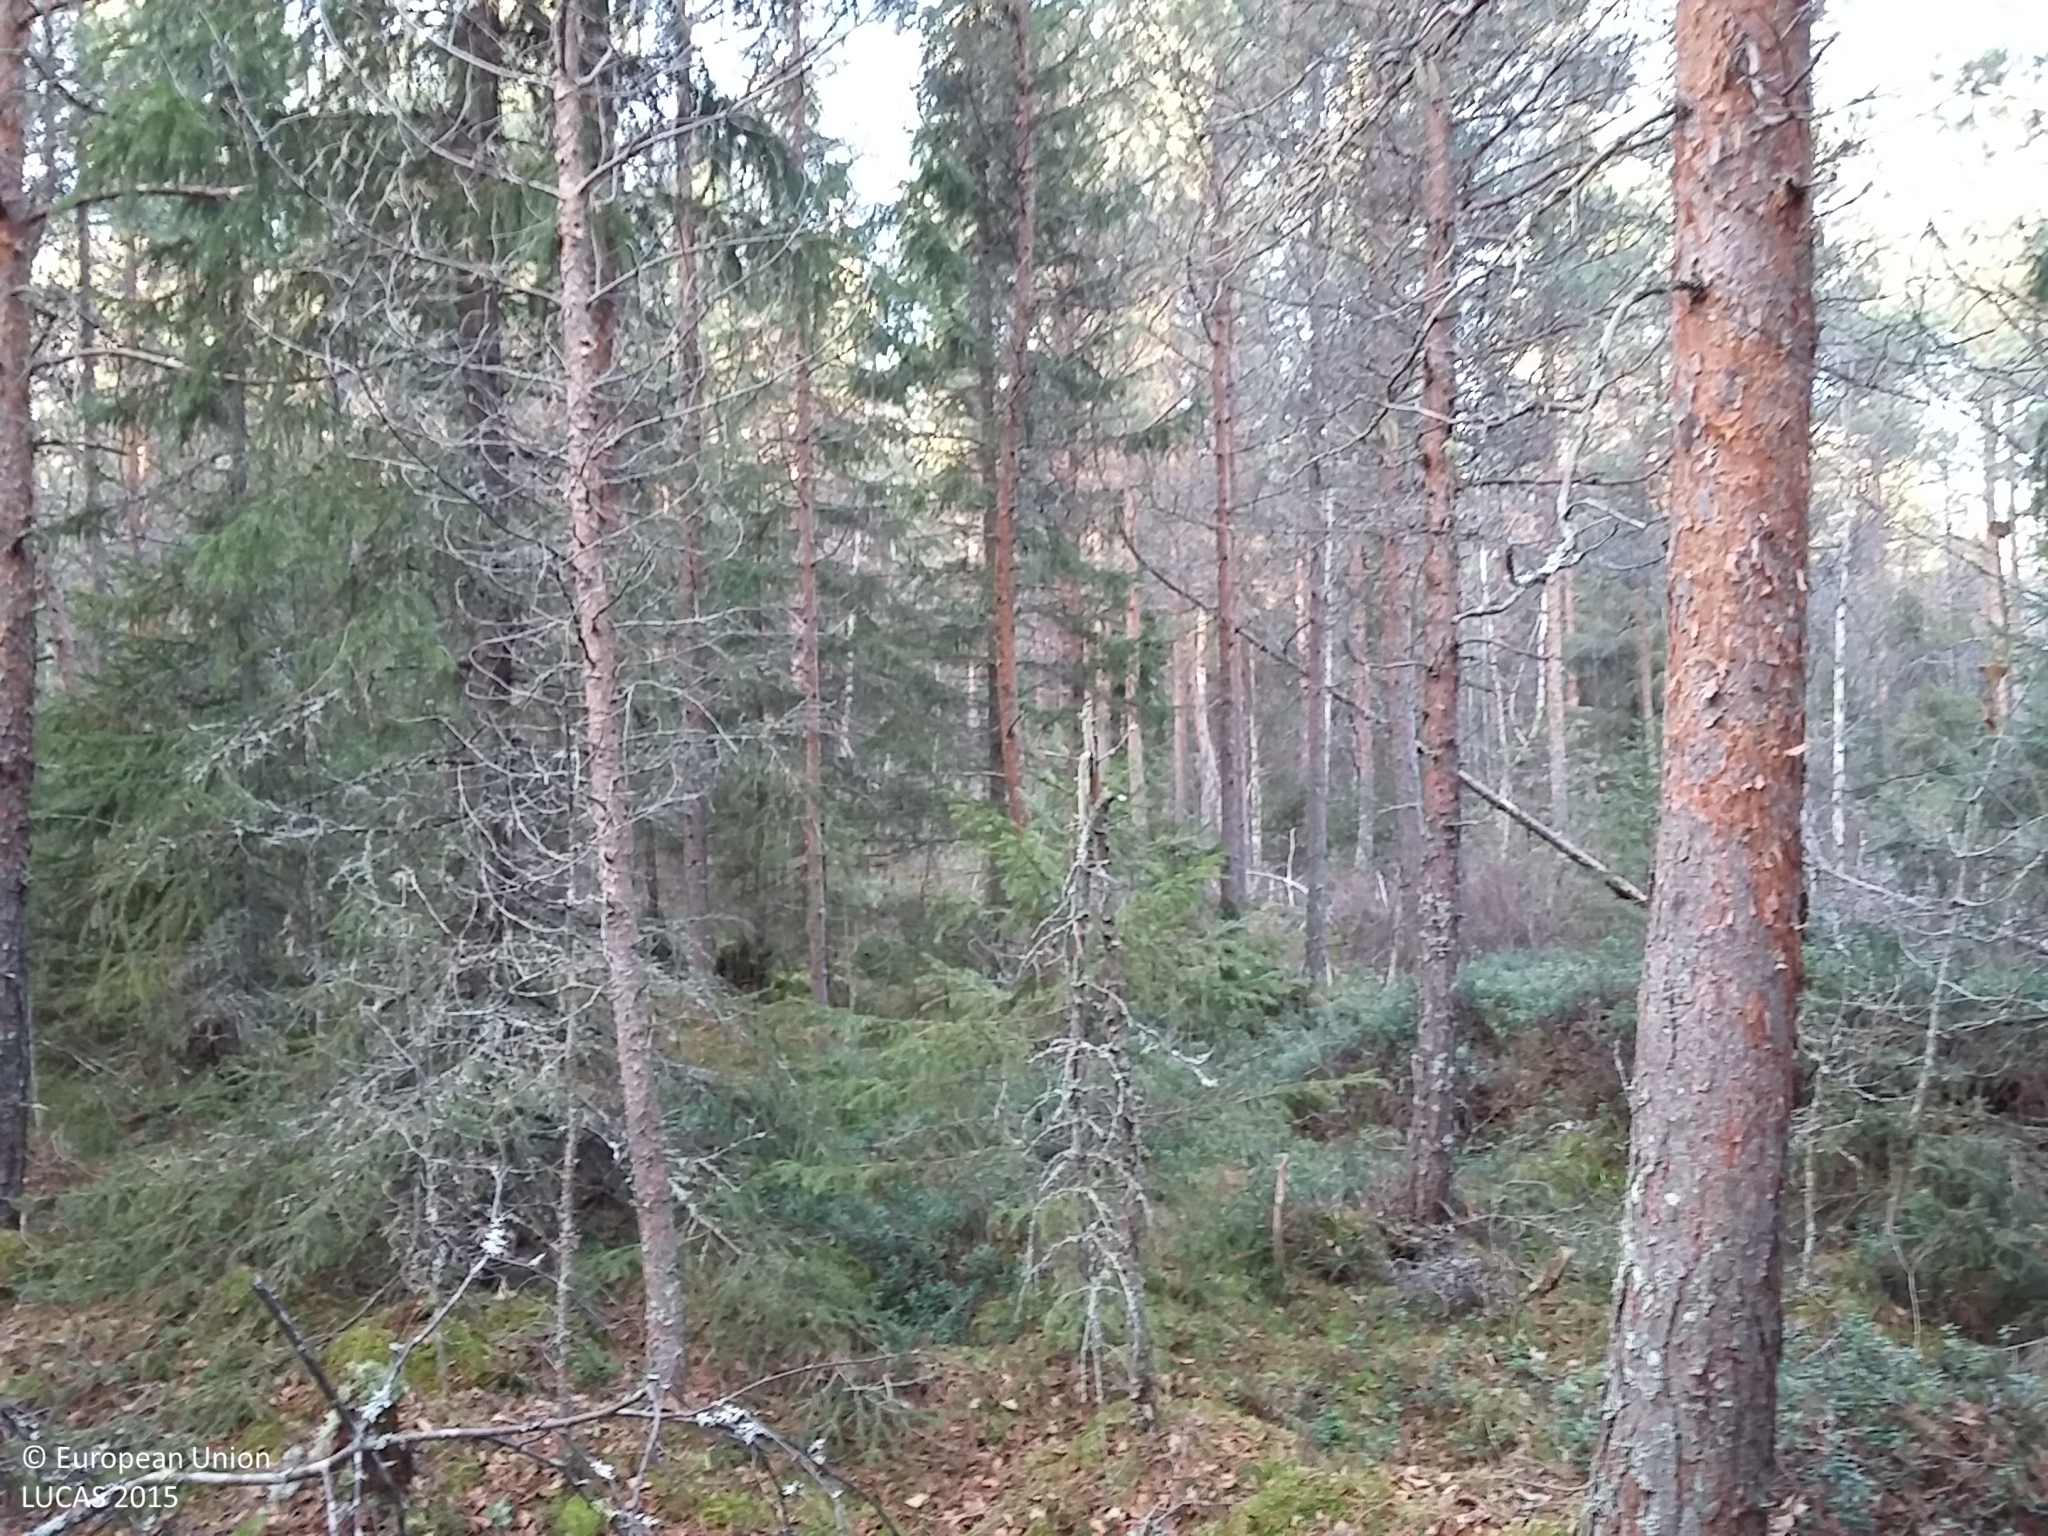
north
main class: Woodland
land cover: Other mixed woodland
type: boreal forest
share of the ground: > 75 %
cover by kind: coniferous forest trees 55 %, broadleaved forest trees 25 %, shrubs 10 %, lichens and mosses 10 %
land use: Forestry
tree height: > 5 m
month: October
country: FI
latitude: 64.5848
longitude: 25.5649
